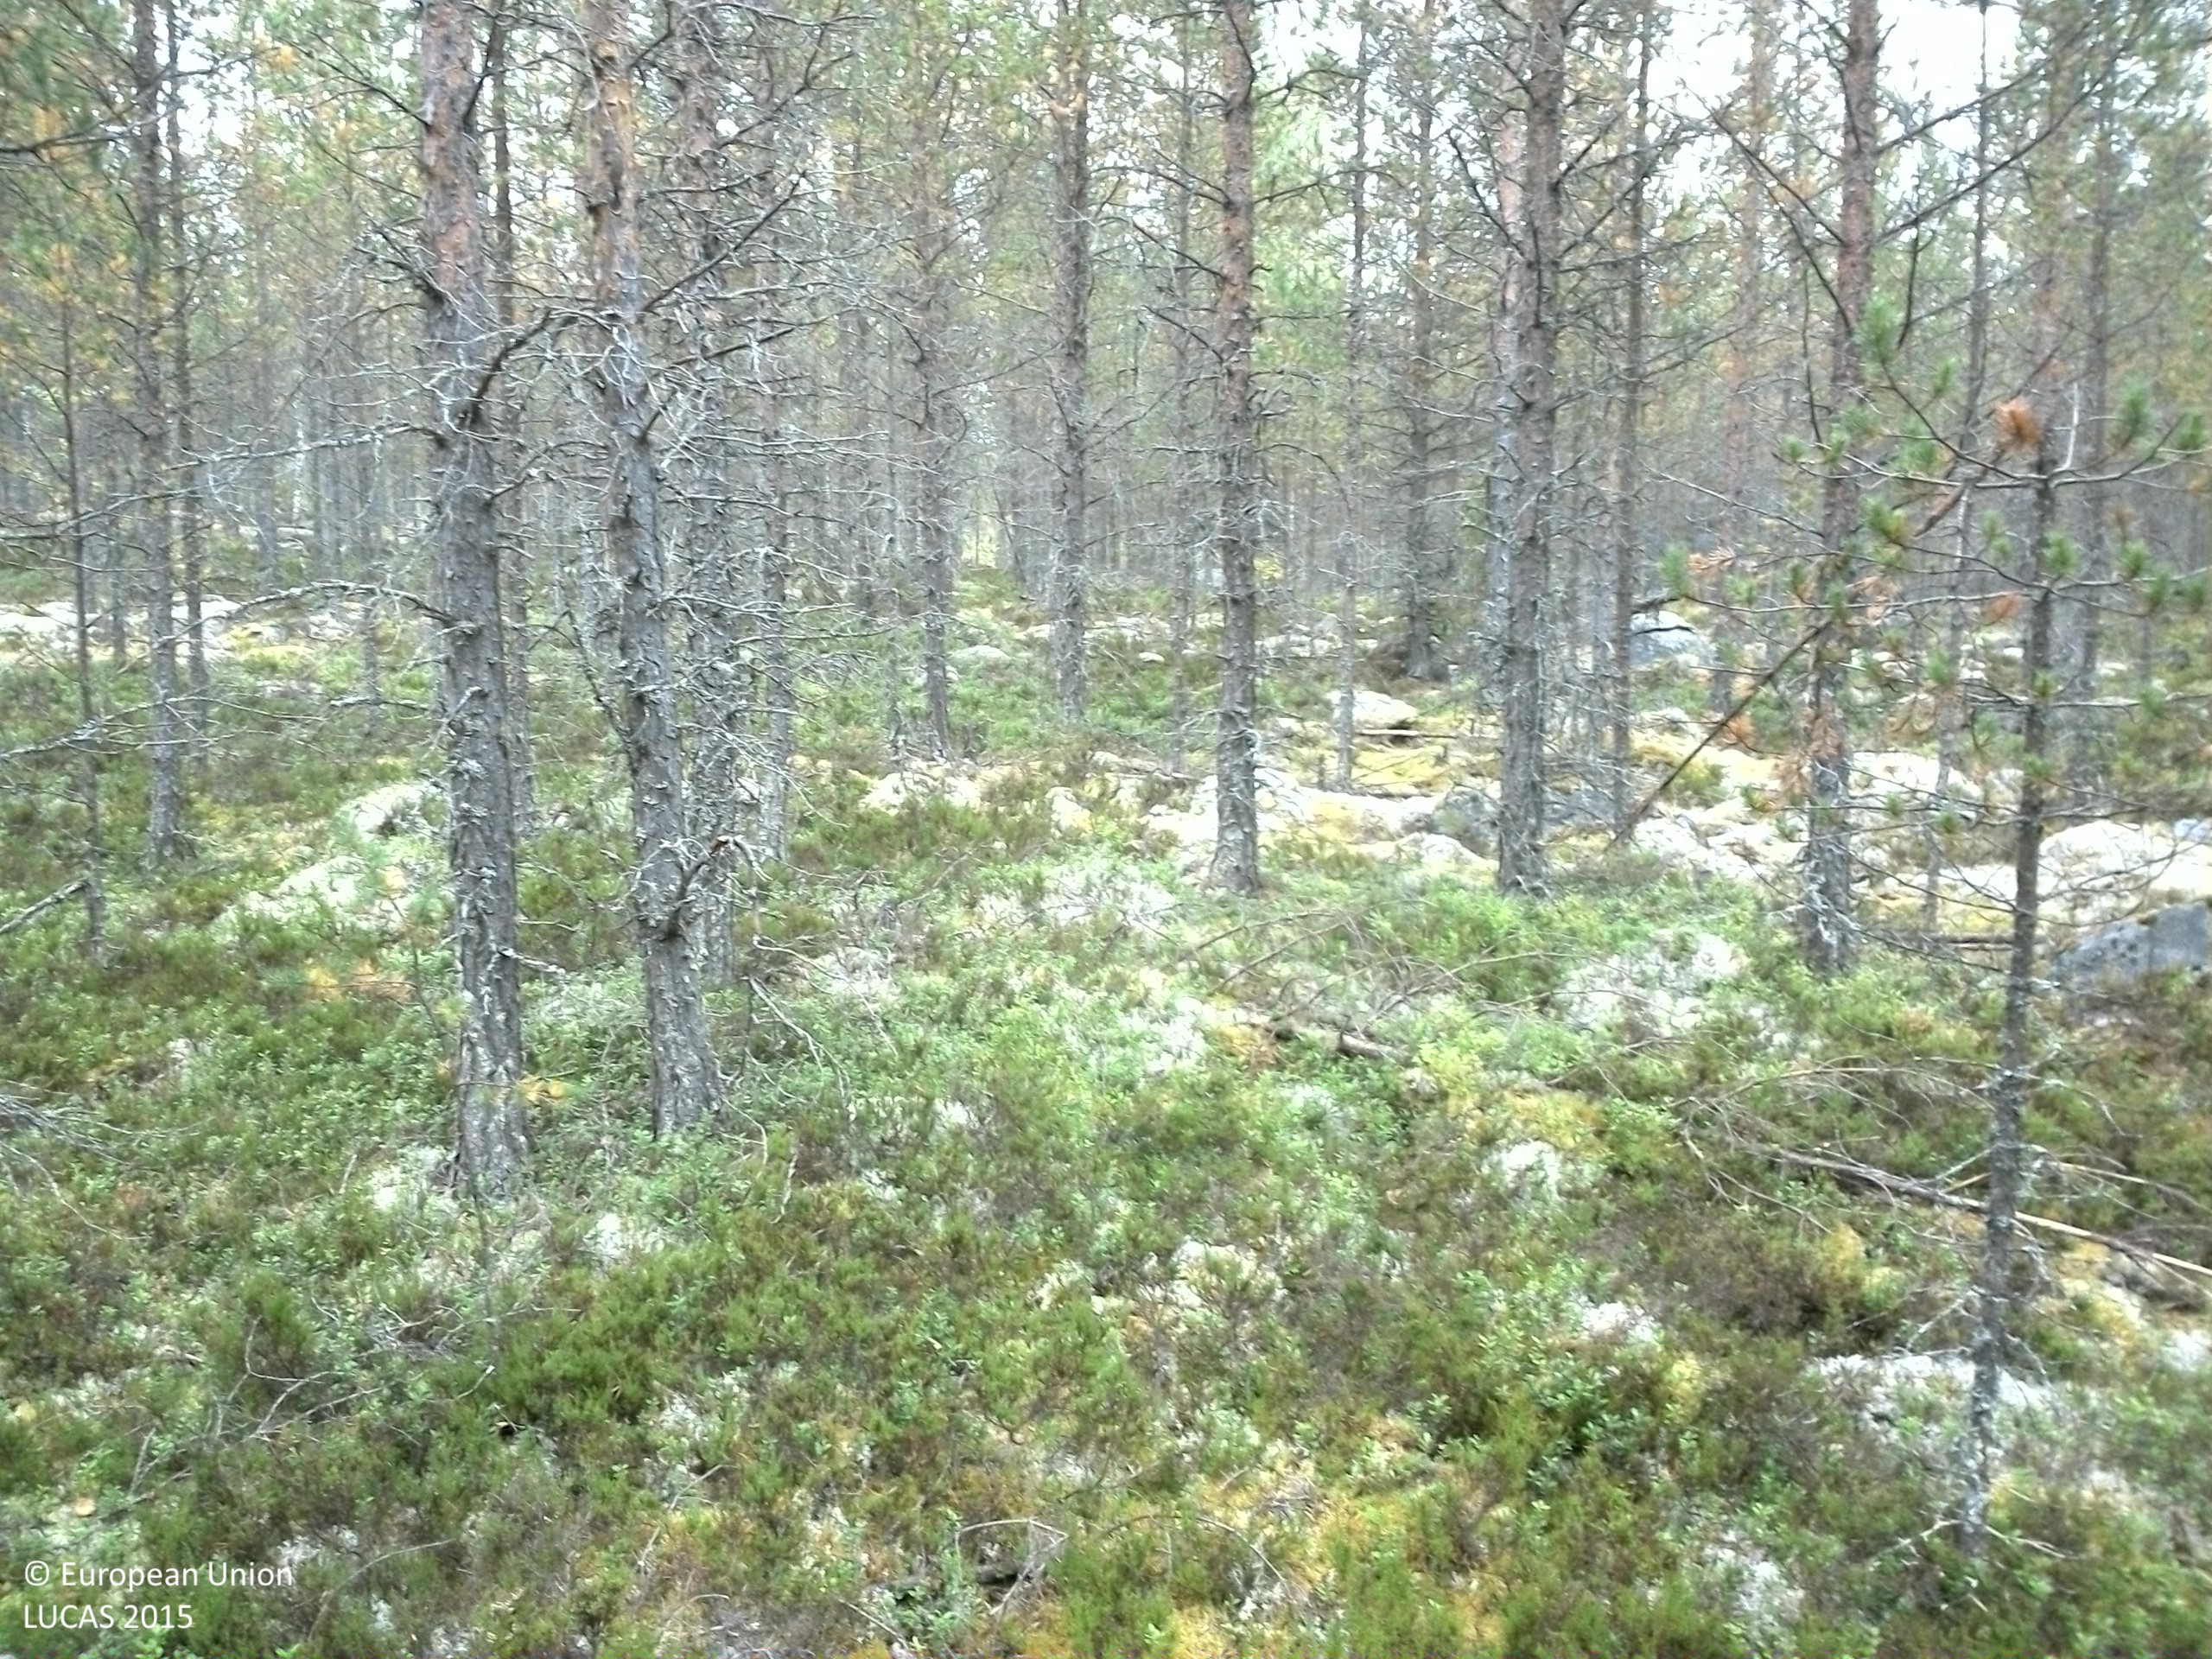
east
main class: Woodland
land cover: Pine dominated coniferous woodland
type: boreal forest
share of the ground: > 75 %
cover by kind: coniferous forest trees 75 %, shrubs 25 %
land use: Forestry
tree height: < 5 m
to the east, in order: Pine dominated coniferous woodland; Shrubland without tree cover; Electric lines; Shrubland with sparse tree cover; Pine dominated coniferous woodland; Other coniferous woodland
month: September
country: SE
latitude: 61.5318
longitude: 15.1181
